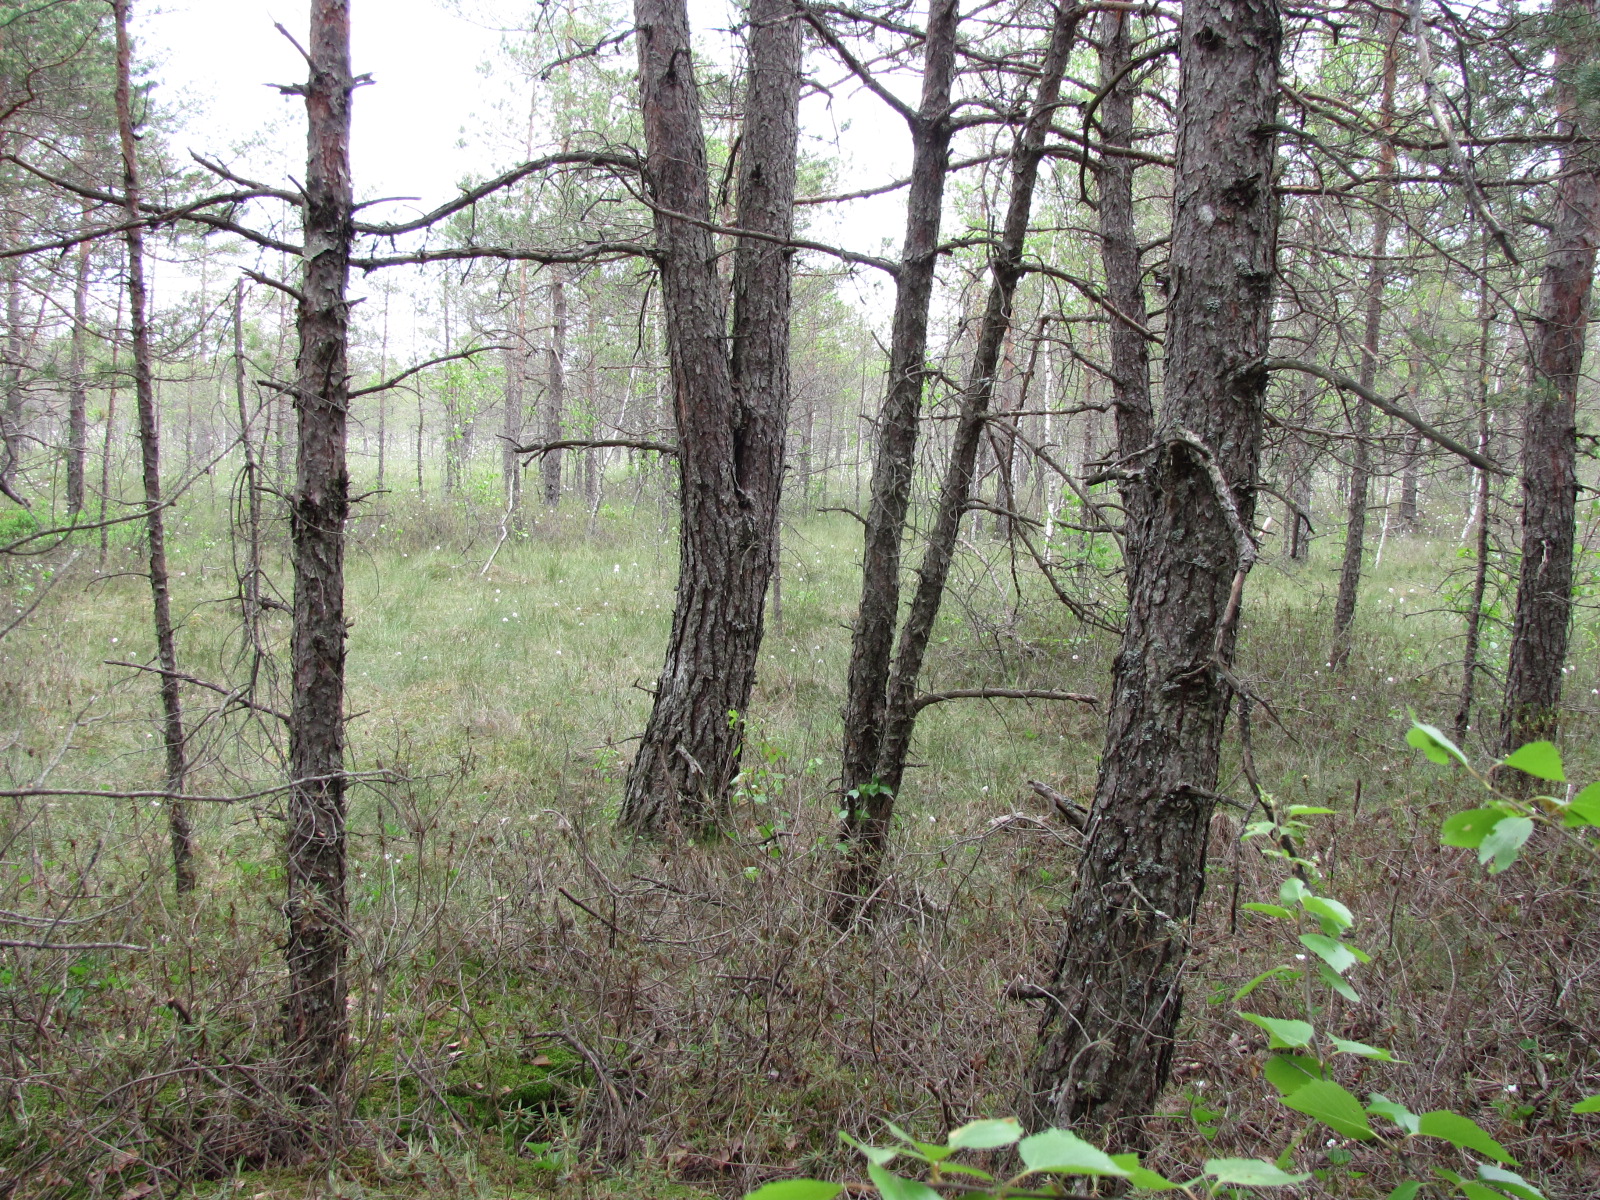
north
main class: Woodland
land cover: Pine dominated coniferous woodland
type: mire and swamp forests
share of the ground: > 75 %
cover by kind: coniferous forest trees 75 %, lichens and mosses 15 %, broadleaved forest trees 5 %, herbaceous plants 5 %
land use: Semi-natural and natural areas not in use
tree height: > 5 m
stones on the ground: < 10 %
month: June
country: LV
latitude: 56.8481
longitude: 23.9368
